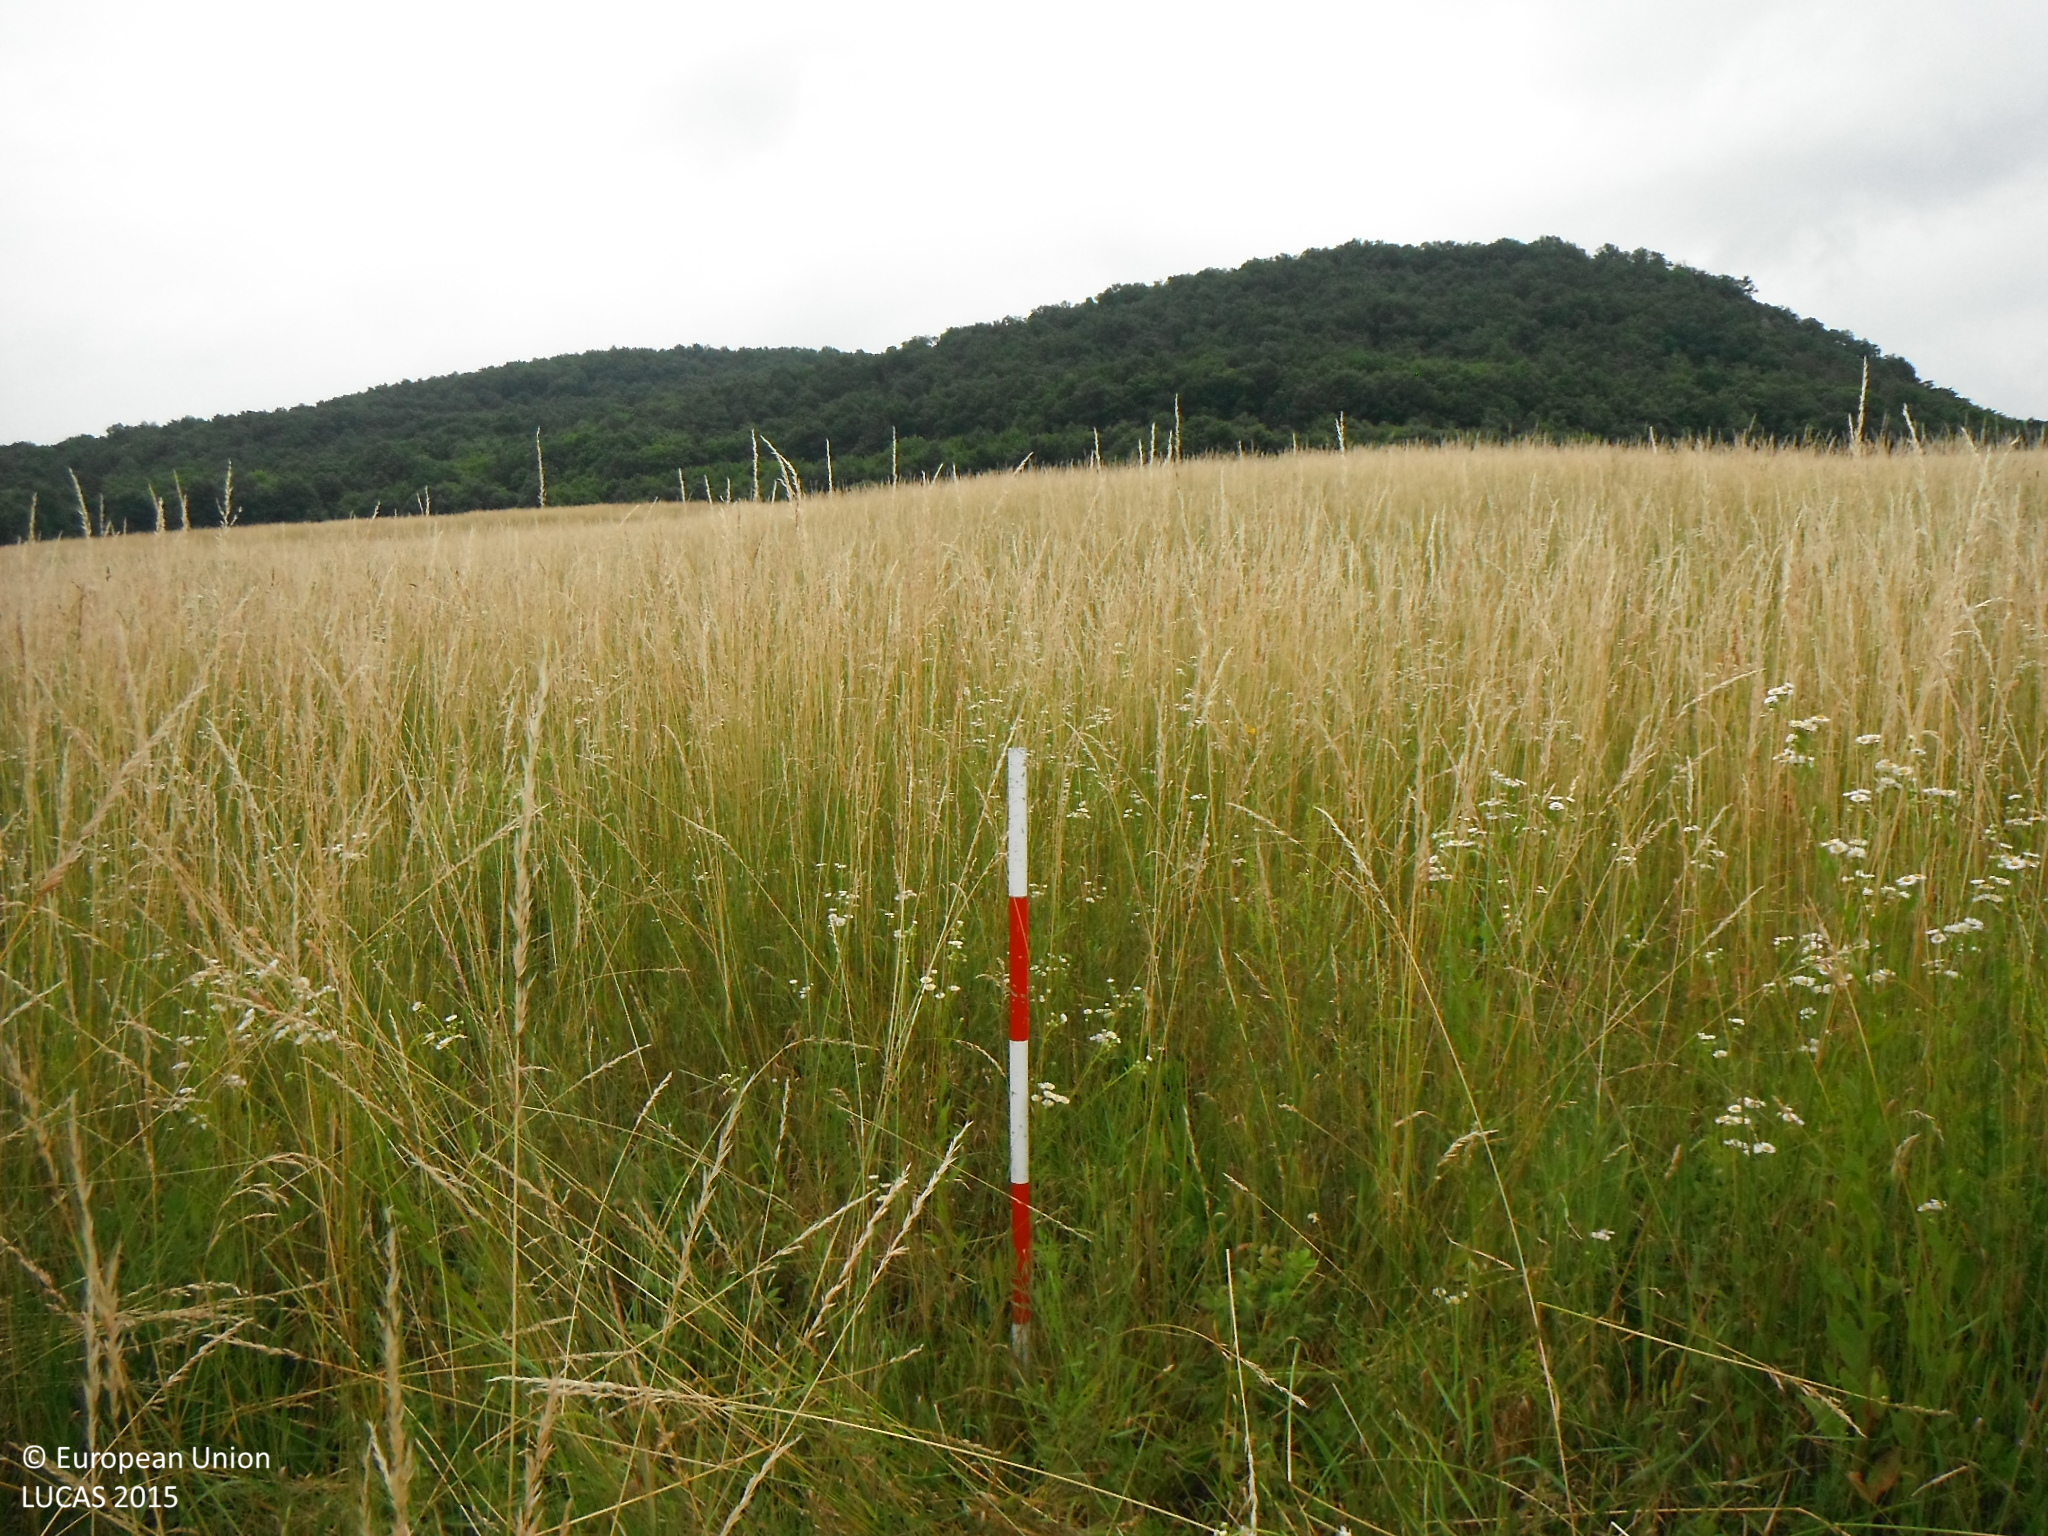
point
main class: Grassland
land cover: Grassland without tree/shrub cover
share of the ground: > 75 %
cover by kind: herbaceous plants 100 %
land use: Agriculture (excluding fallow land and kitchen gardens)
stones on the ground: < 10 %
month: June
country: SK
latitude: 48.5007
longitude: 20.1135
